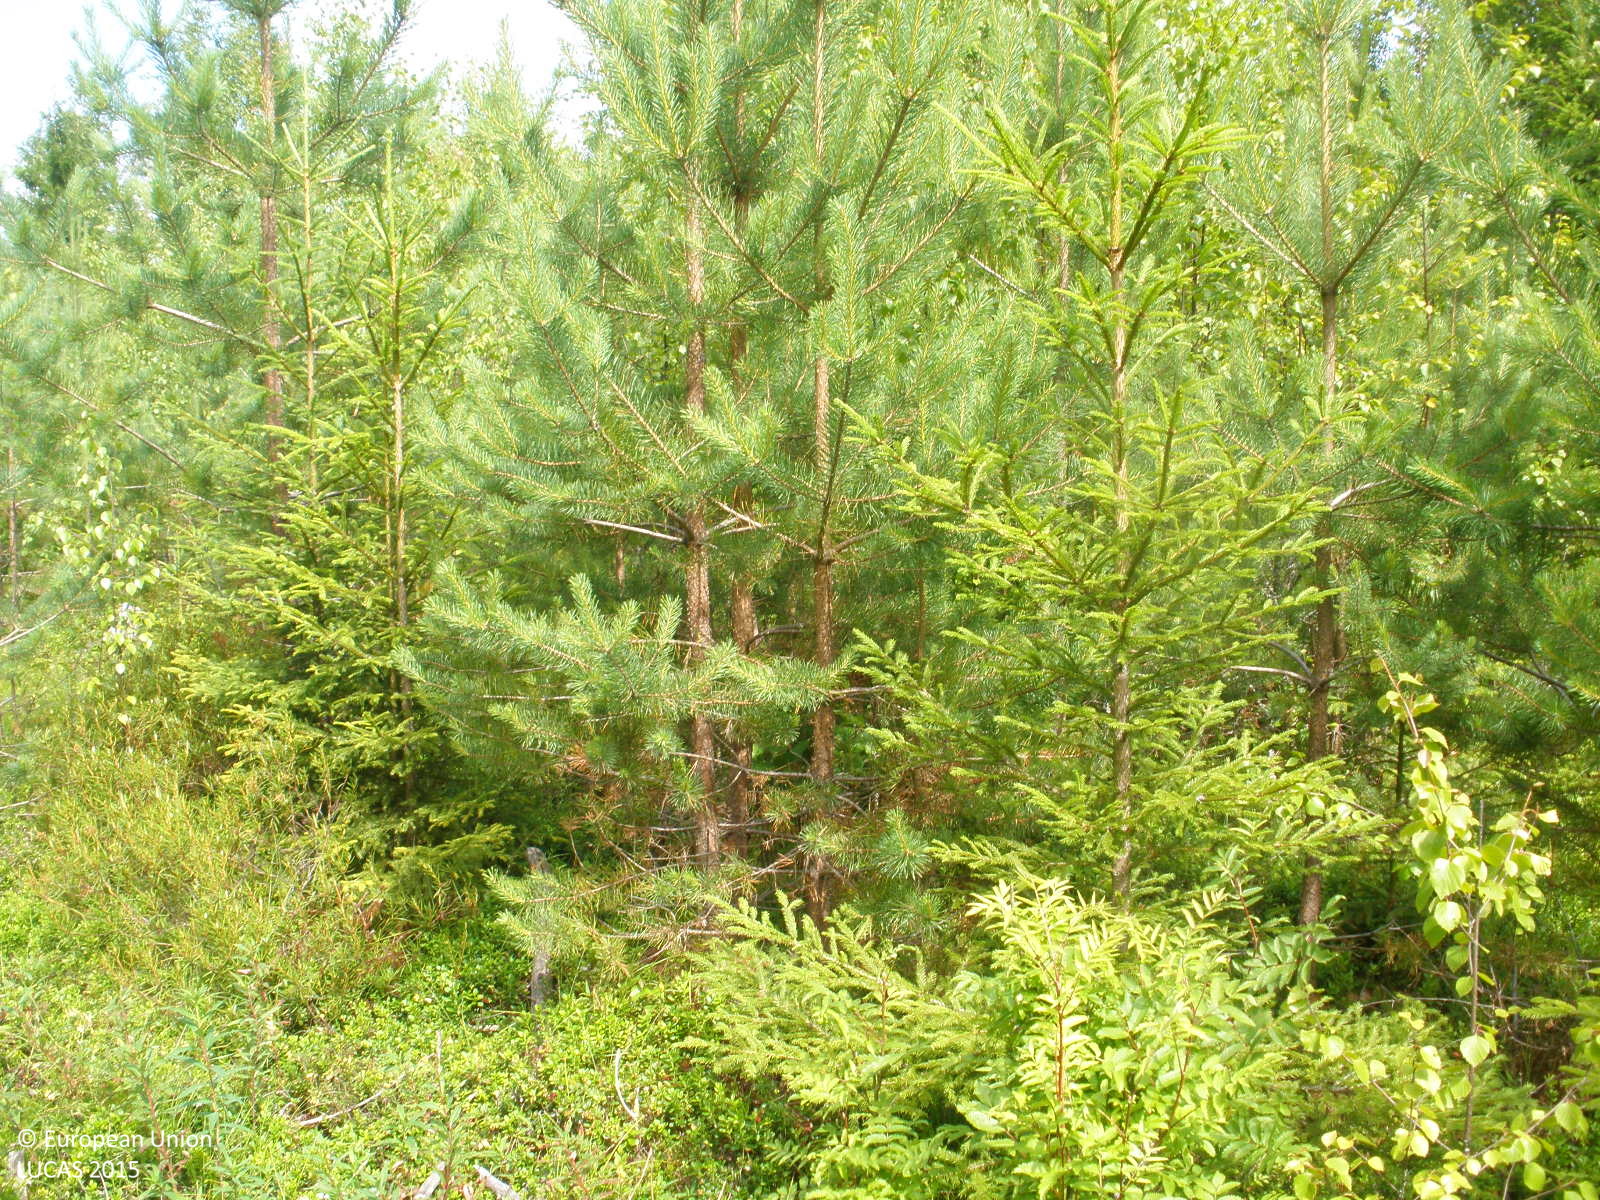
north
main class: Woodland
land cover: Pine dominated mixed woodland
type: boreal forest
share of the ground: 50 - 75 %
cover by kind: coniferous forest trees 40 %, broadleaved forest trees 30 %, herbaceous plants 15 %, lichens and mosses 10 %, shrubs 5 %
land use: Forestry
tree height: < 5 m
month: July
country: FI
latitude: 61.4877
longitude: 24.8095
